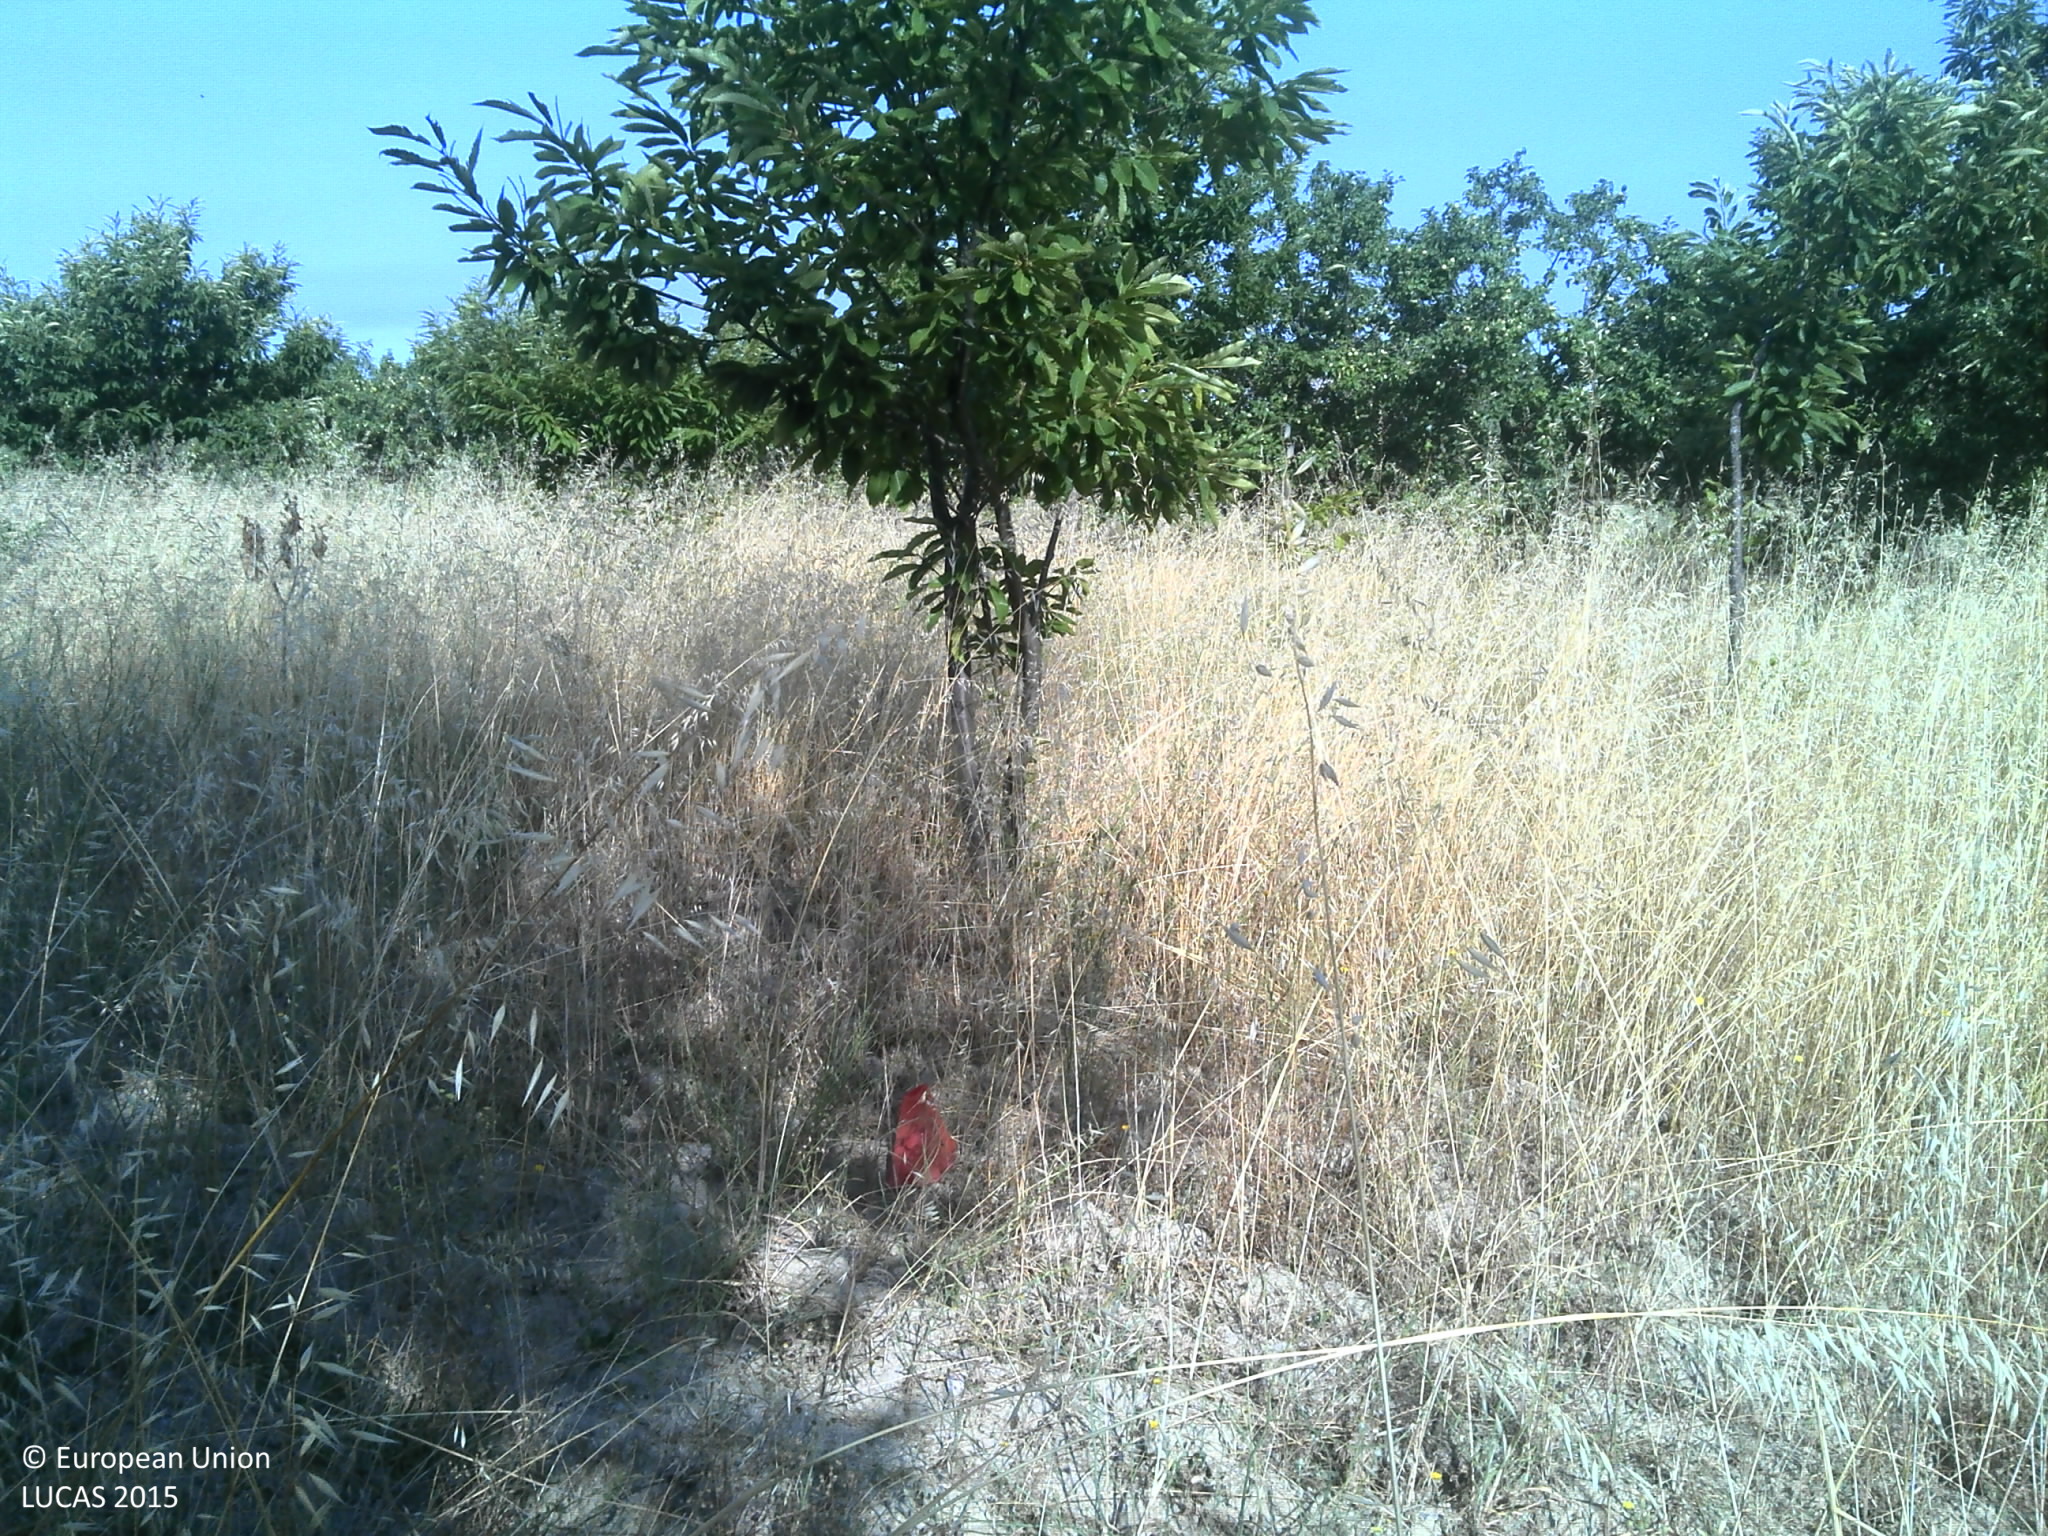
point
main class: Cropland
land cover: Nuts trees
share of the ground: < 10 %
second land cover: Spontaneously vegetated surfaces
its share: 50 - 75 %
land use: Agriculture (excluding fallow land and kitchen gardens)
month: July
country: PT
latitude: 40.9456
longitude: -7.4238
